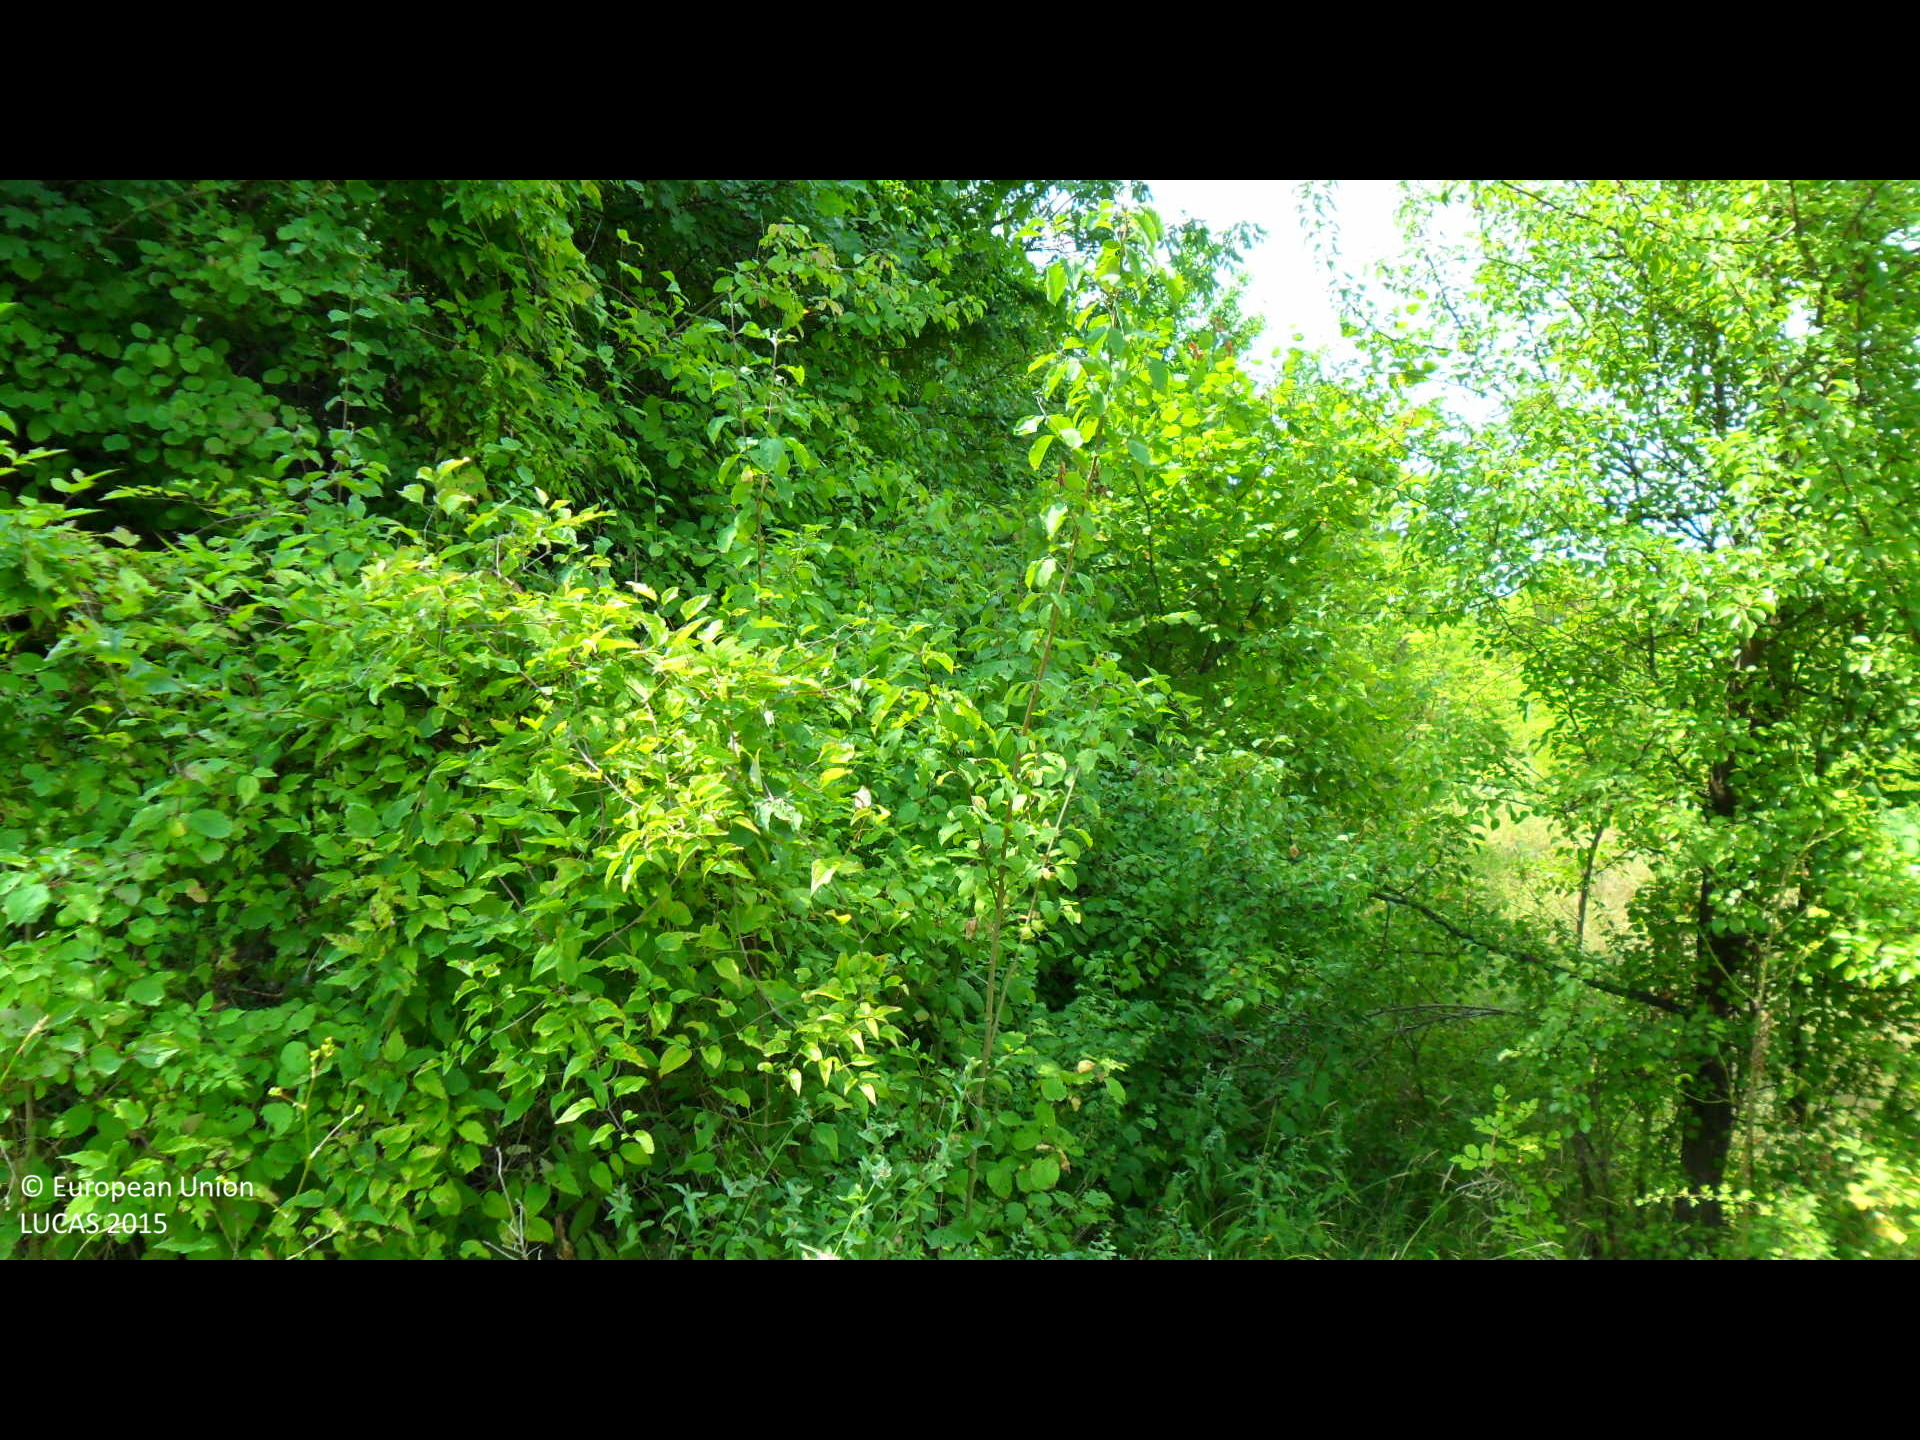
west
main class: Woodland
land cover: Broadleaved woodland
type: mesophytic deciduous forest
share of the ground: > 75 %
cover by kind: broadleaved forest trees 90 %, shrubs 10 %
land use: Forestry
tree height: > 5 m
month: July
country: BG
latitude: 43.3596
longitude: 26.3244
